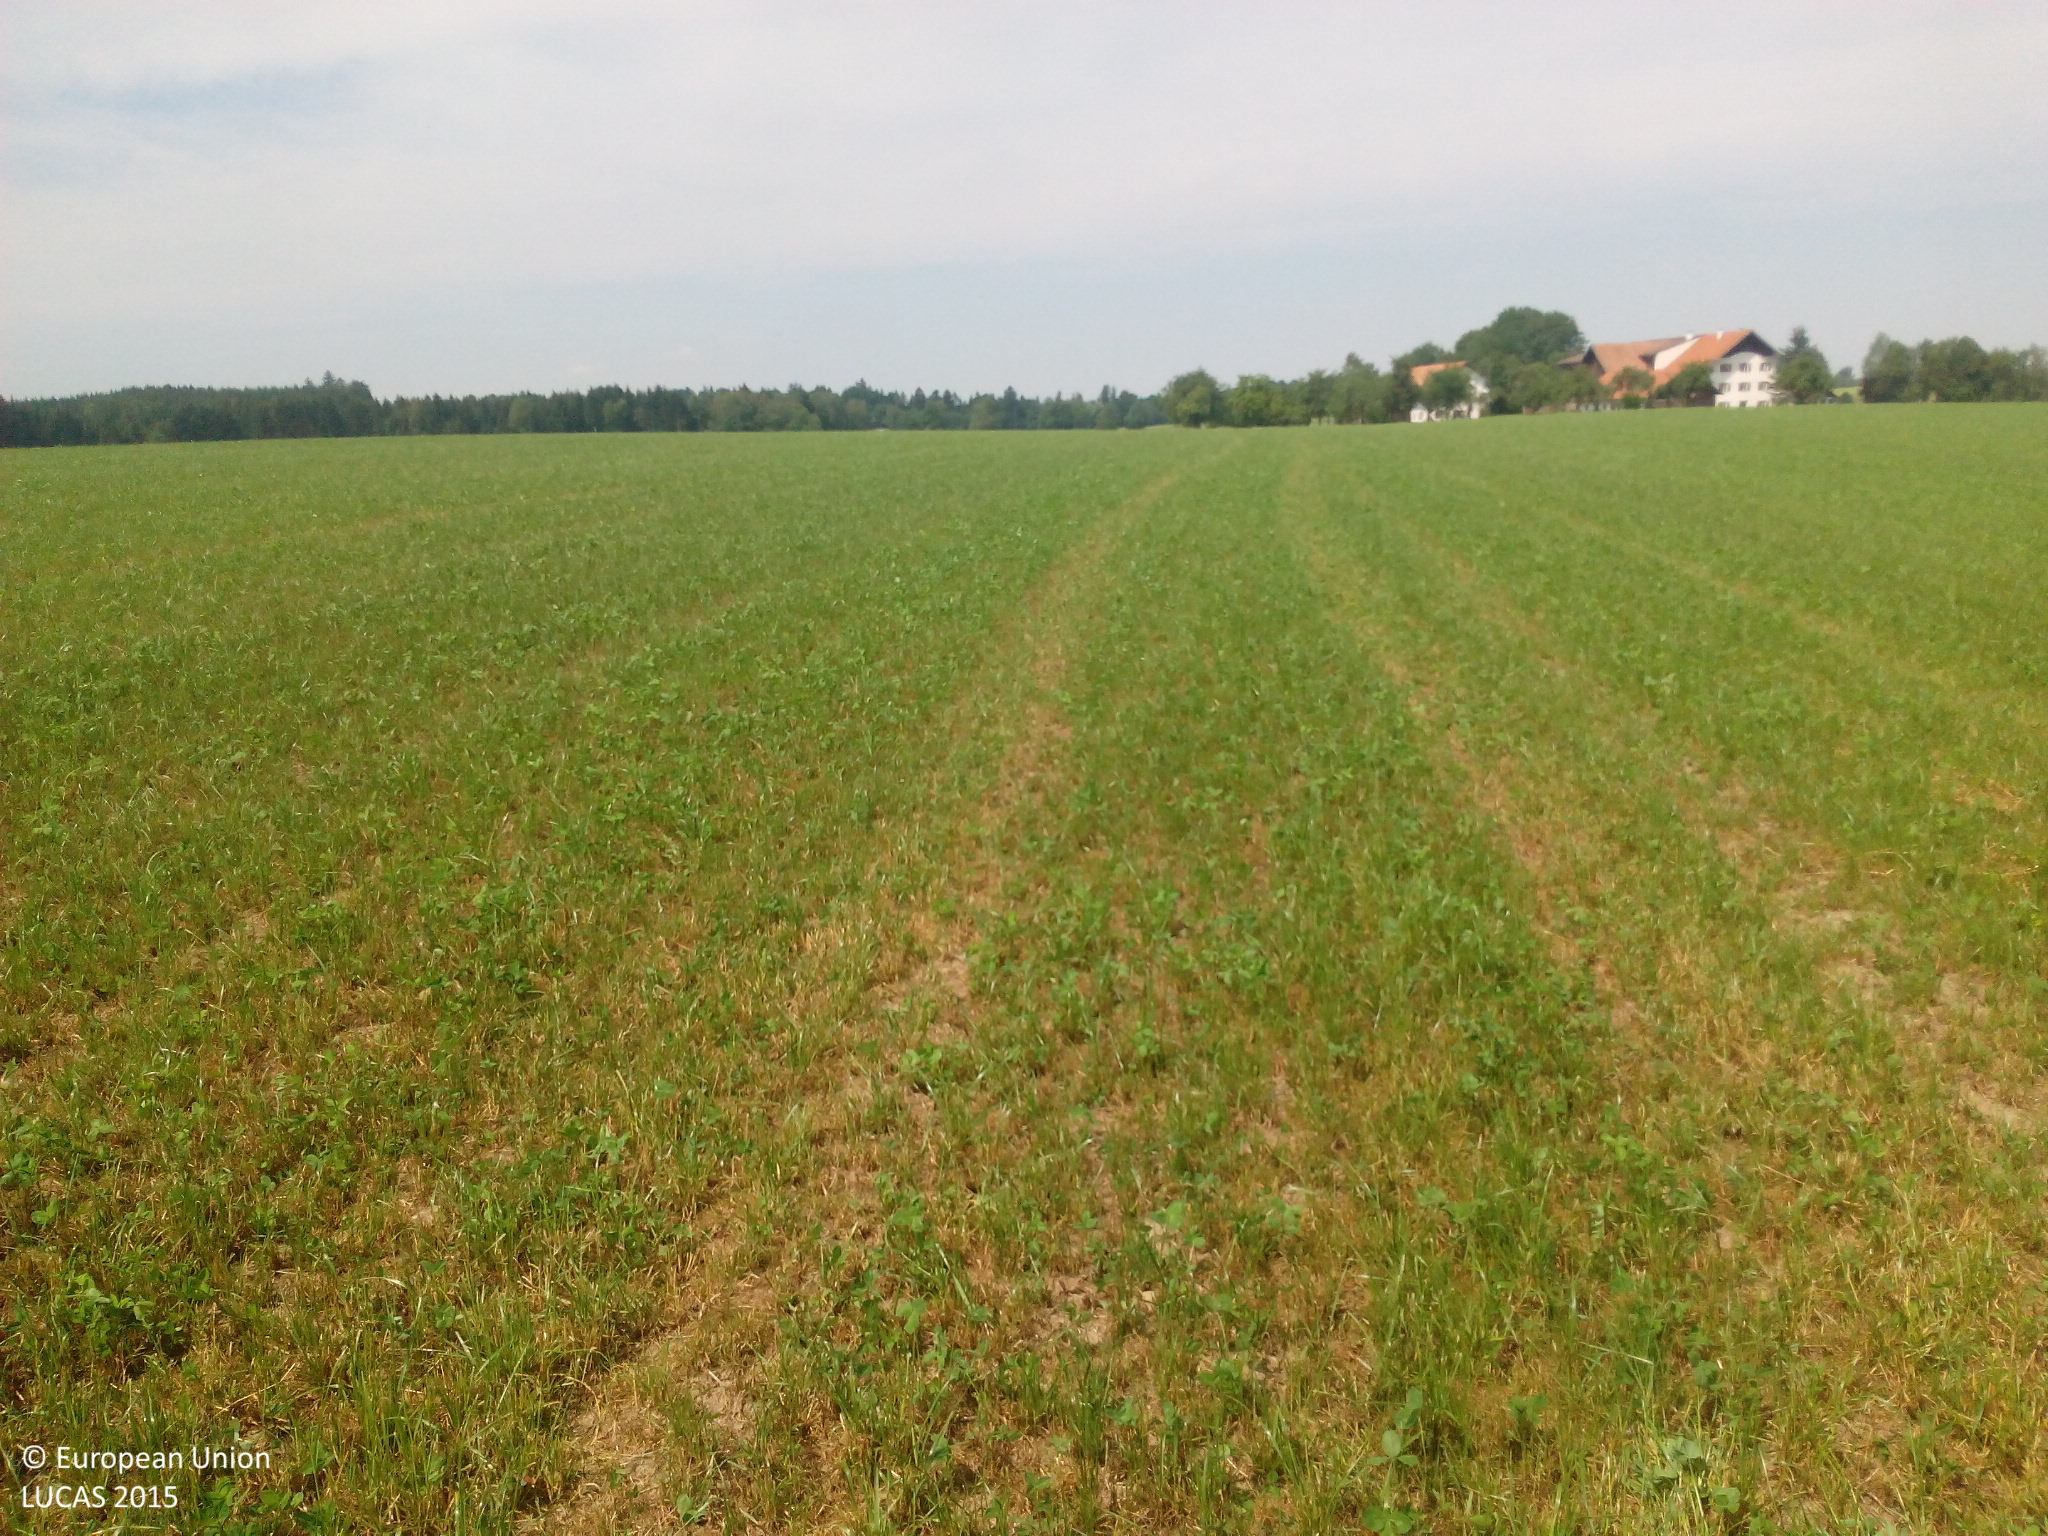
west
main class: Cropland
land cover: Temporary grasslands
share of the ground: 50 - 75 %
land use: Agriculture (excluding fallow land and kitchen gardens)
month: July
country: DE
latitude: 47.8595
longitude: 10.9483
